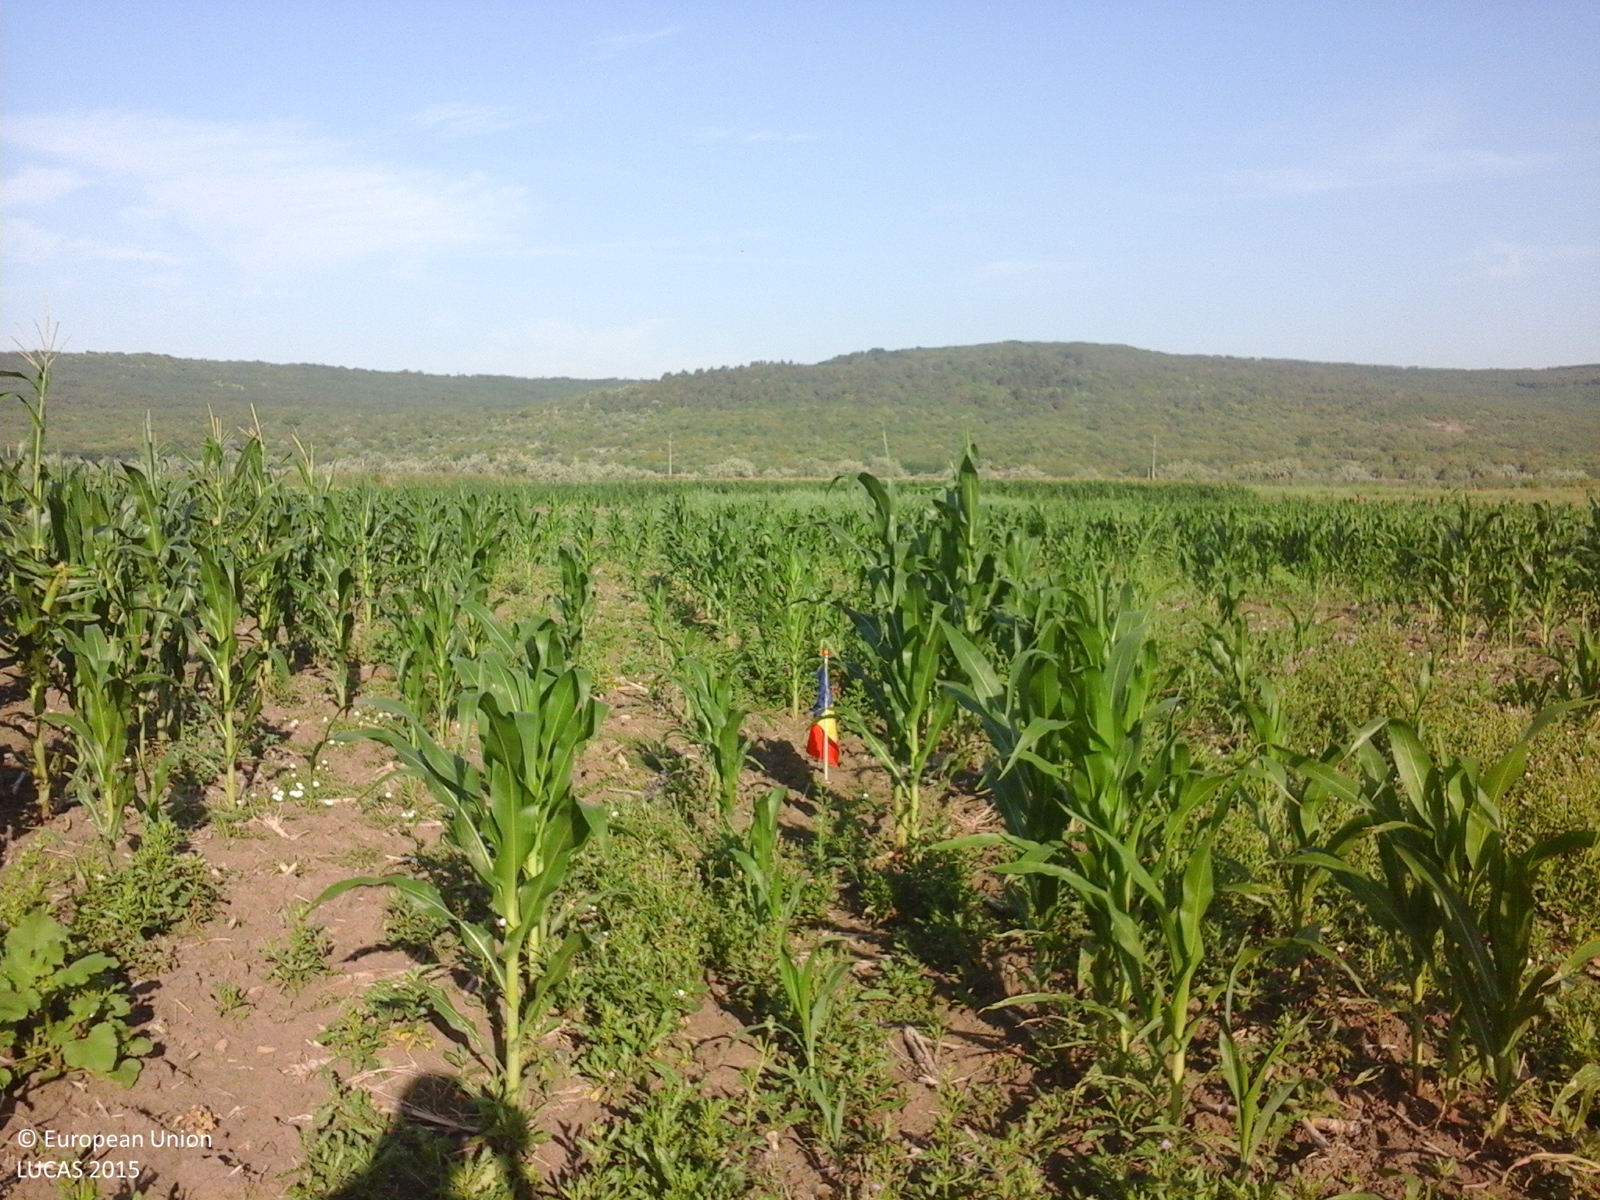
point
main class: Cropland
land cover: Maize
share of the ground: 50 - 75 %
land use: Agriculture (excluding fallow land and kitchen gardens)
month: July
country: RO
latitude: 46.5096
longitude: 28.1825
